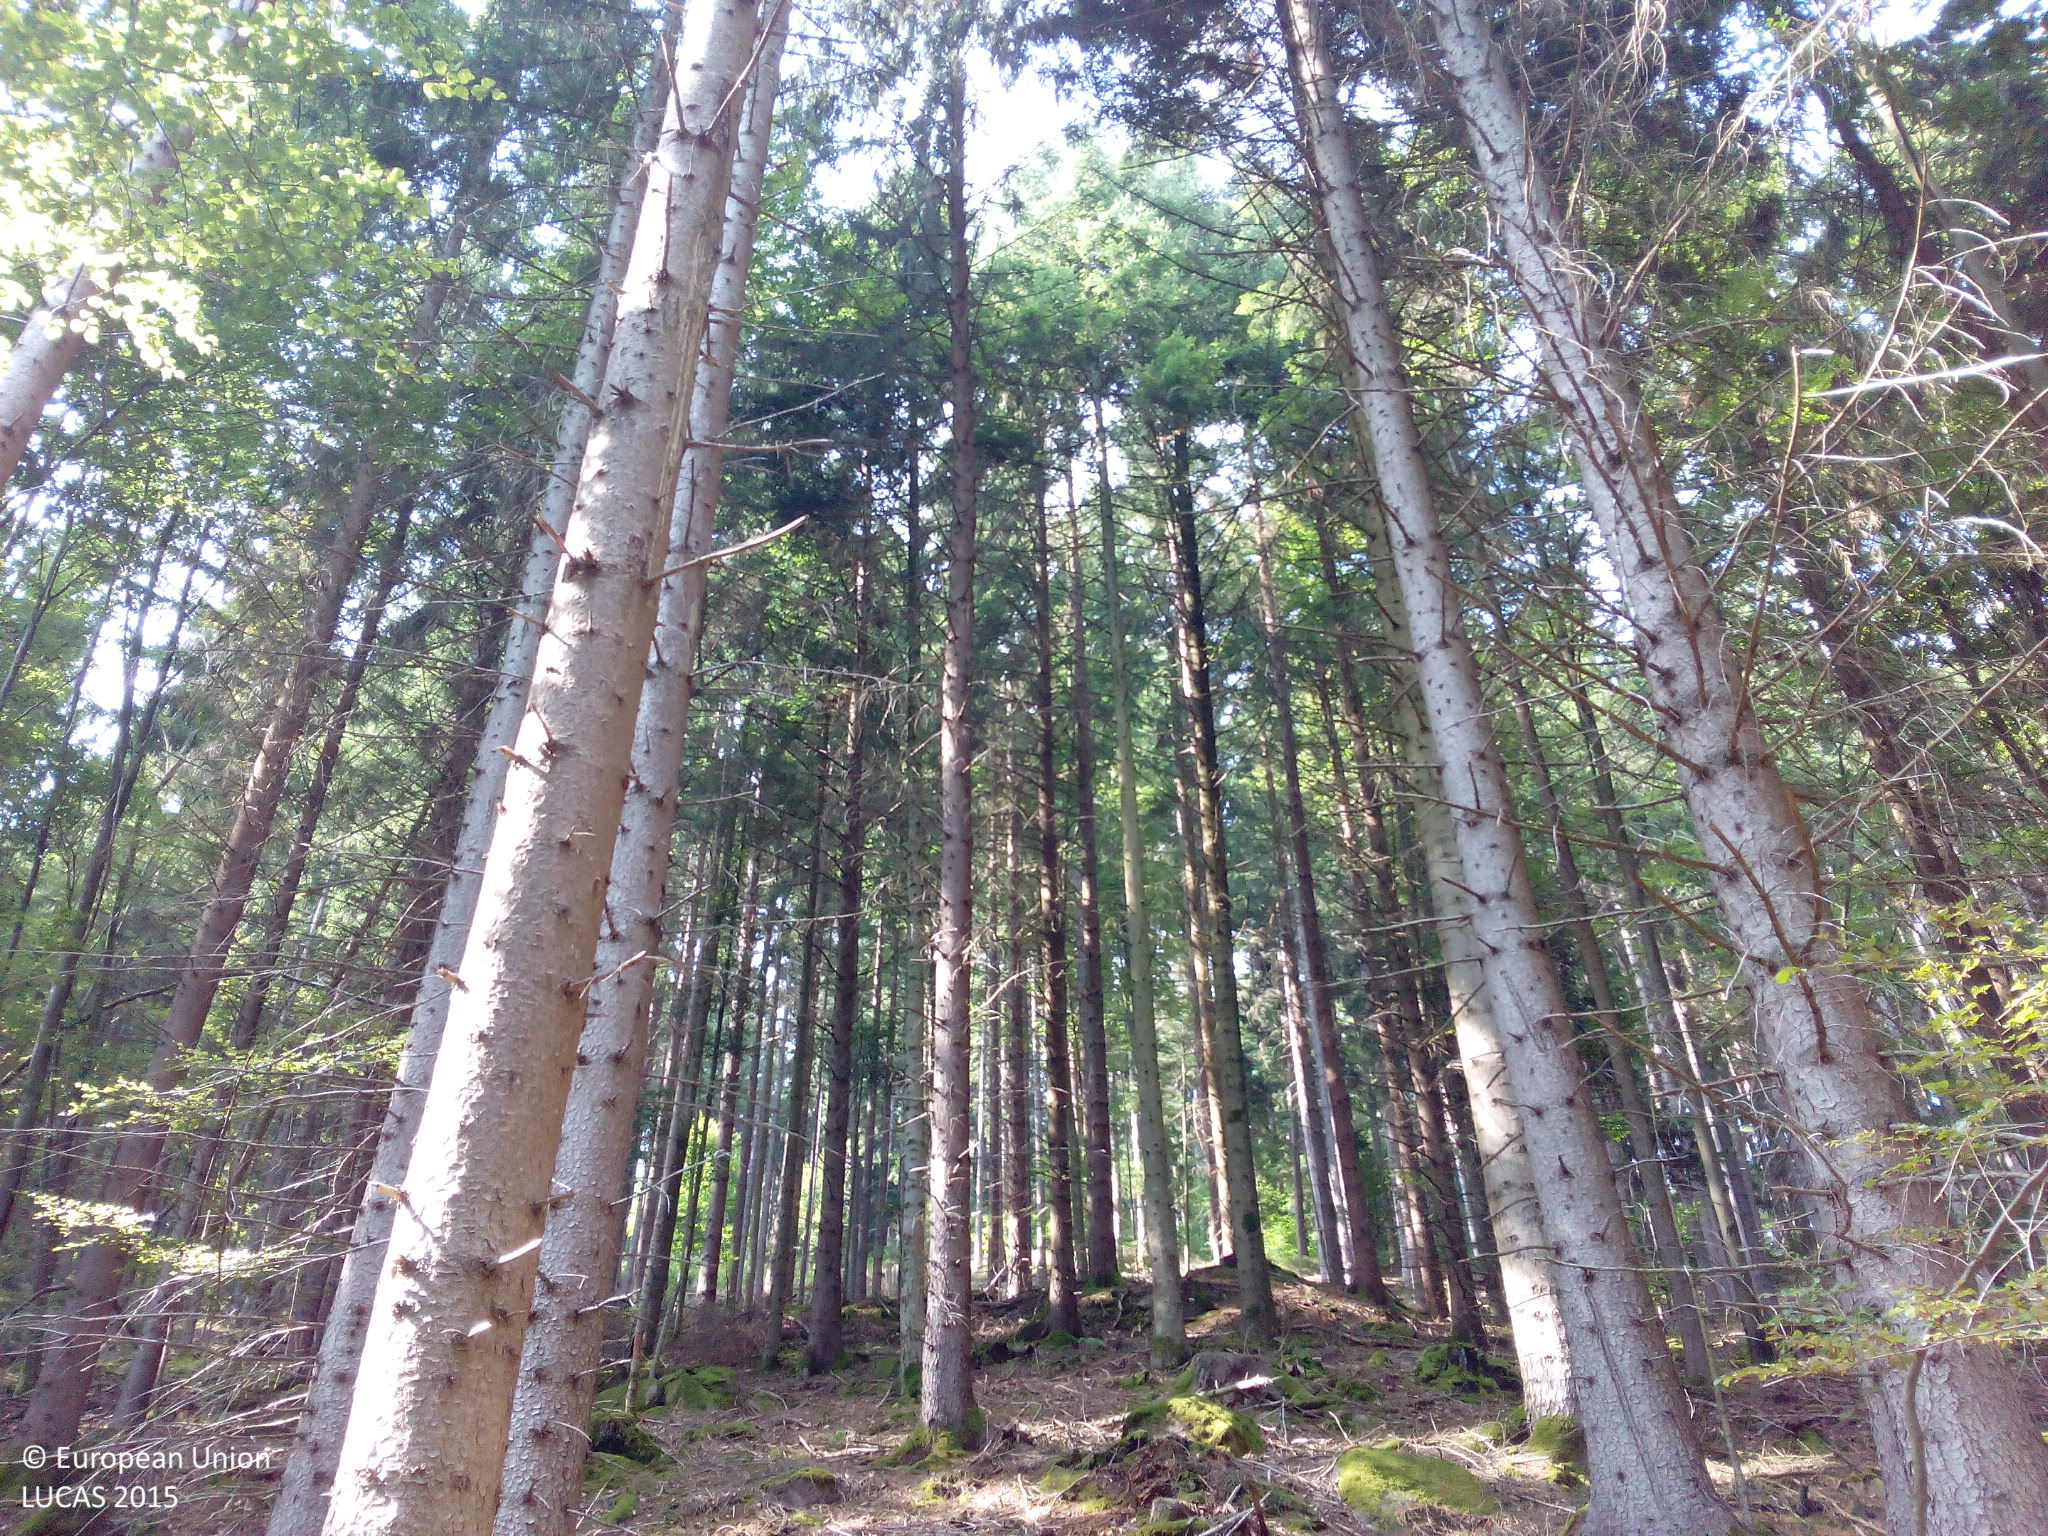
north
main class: Woodland
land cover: Spruce dominated mixed woodland
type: hemiboreal forest and nemoral coniferous forest and mixed broadleaved-coniferous forest
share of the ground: > 75 %
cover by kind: coniferous forest trees 65 %, broadleaved forest trees 25 %, lichens and mosses 5 %, unconsolidated bare surface 5 %
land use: Forestry
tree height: > 5 m
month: August
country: DE
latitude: 48.8261
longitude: 8.5704
